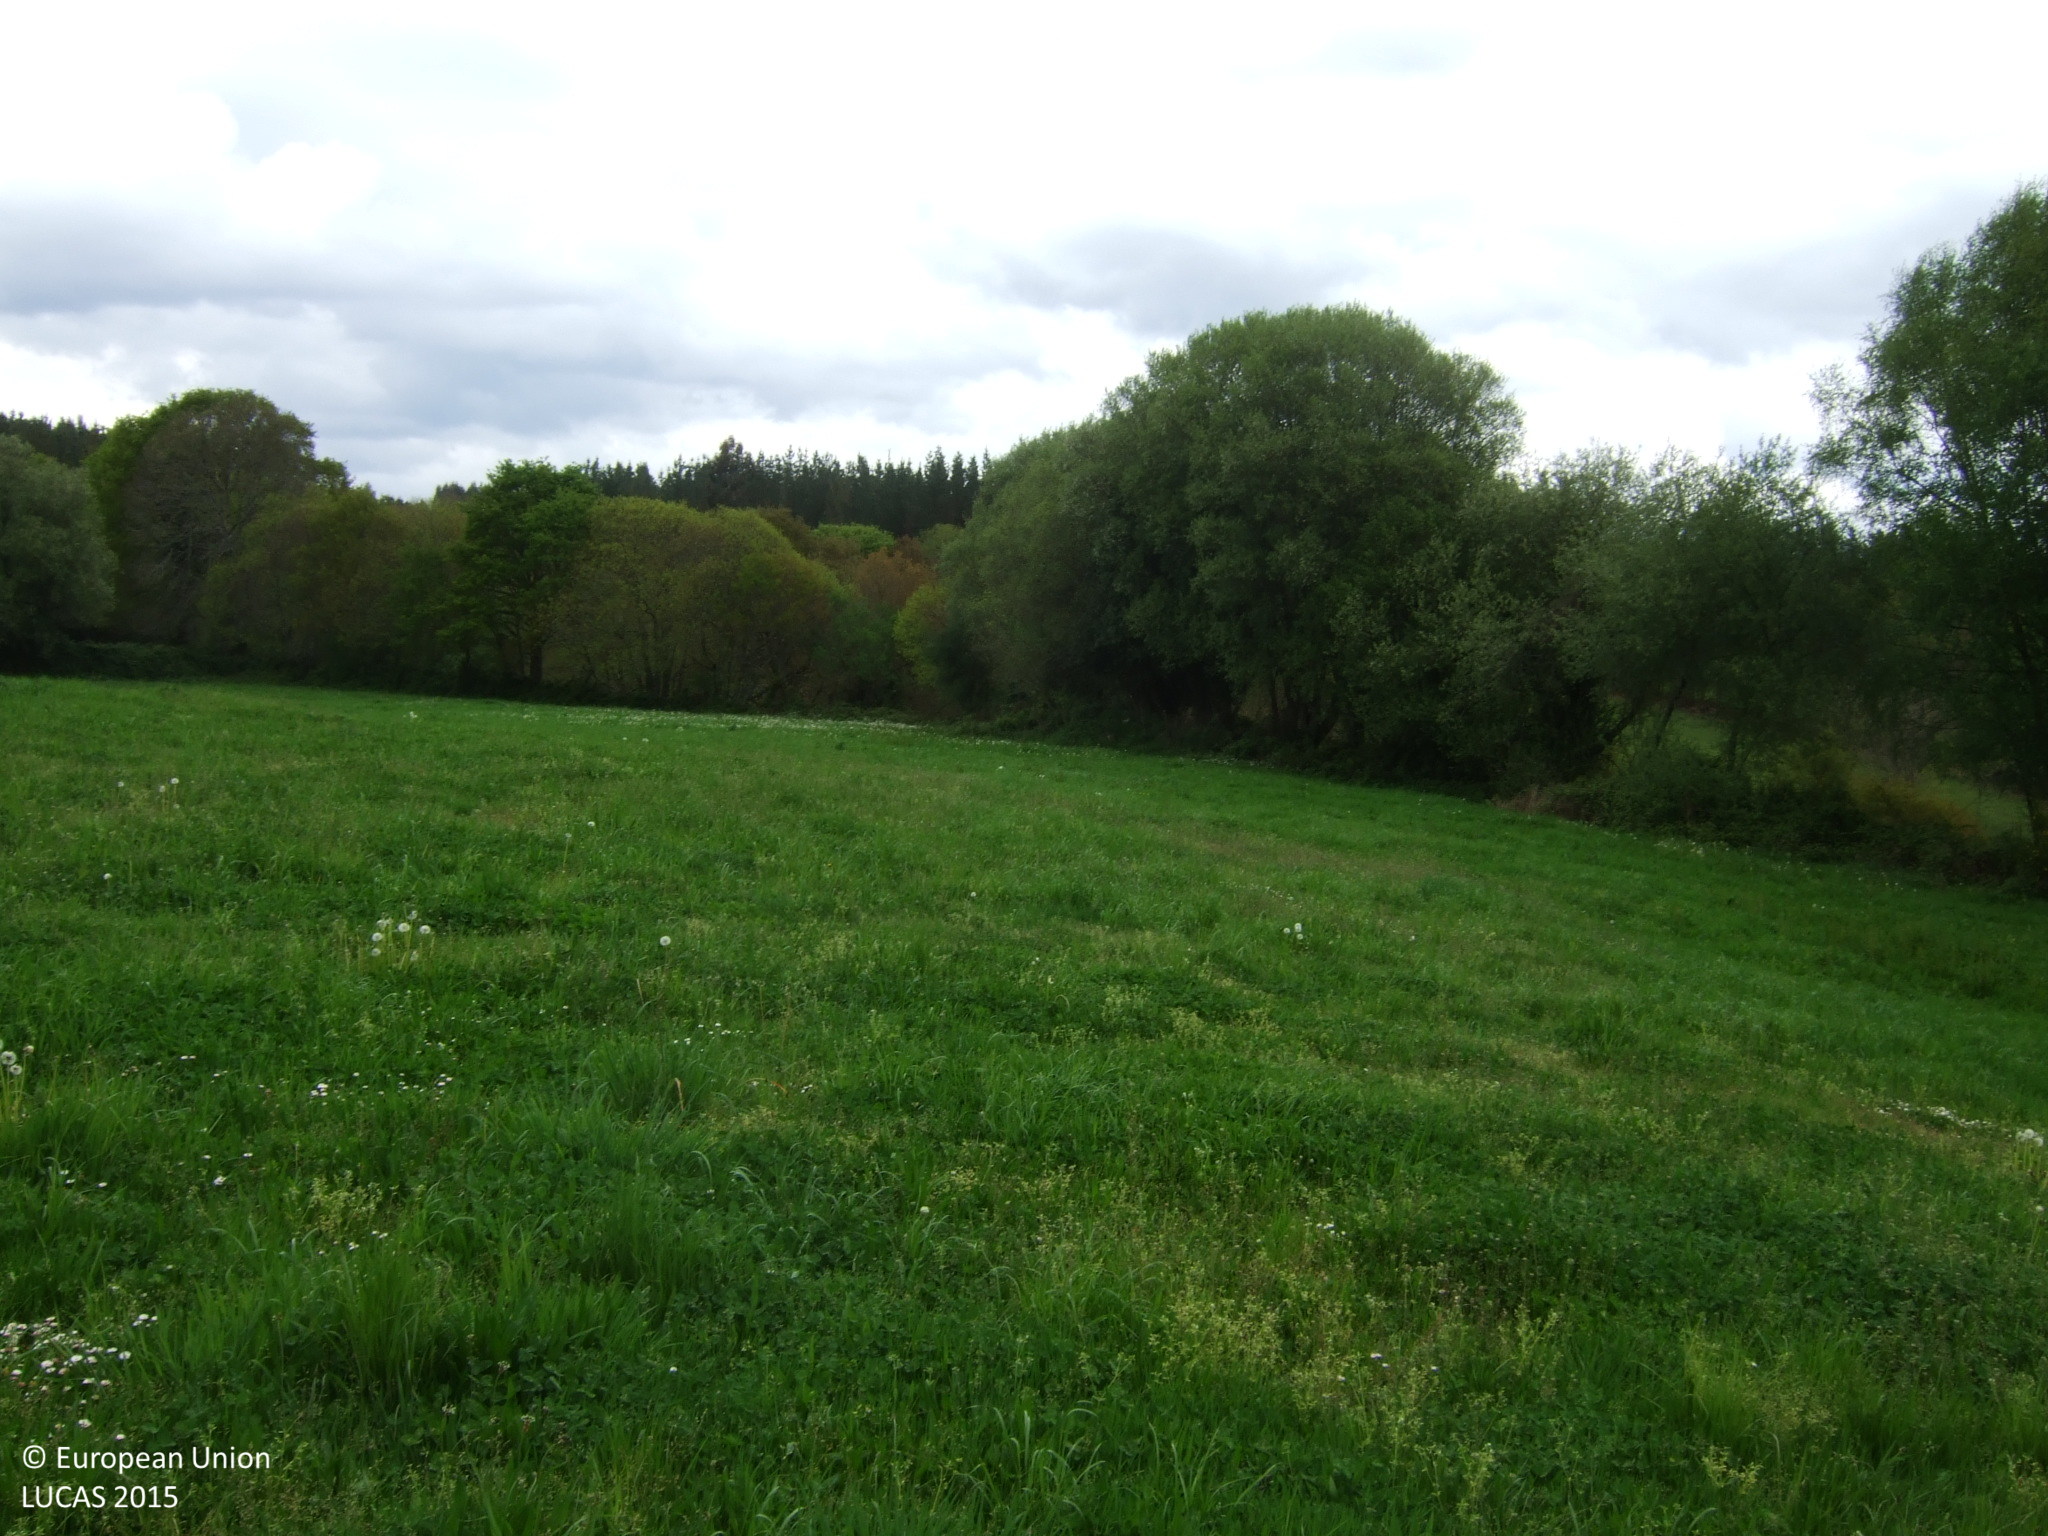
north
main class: Grassland
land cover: Grassland without tree/shrub cover
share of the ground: > 75 %
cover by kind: herbaceous plants 100 %
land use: Agriculture (excluding fallow land and kitchen gardens)
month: April
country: ES
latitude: 43.0457
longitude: -7.8491
